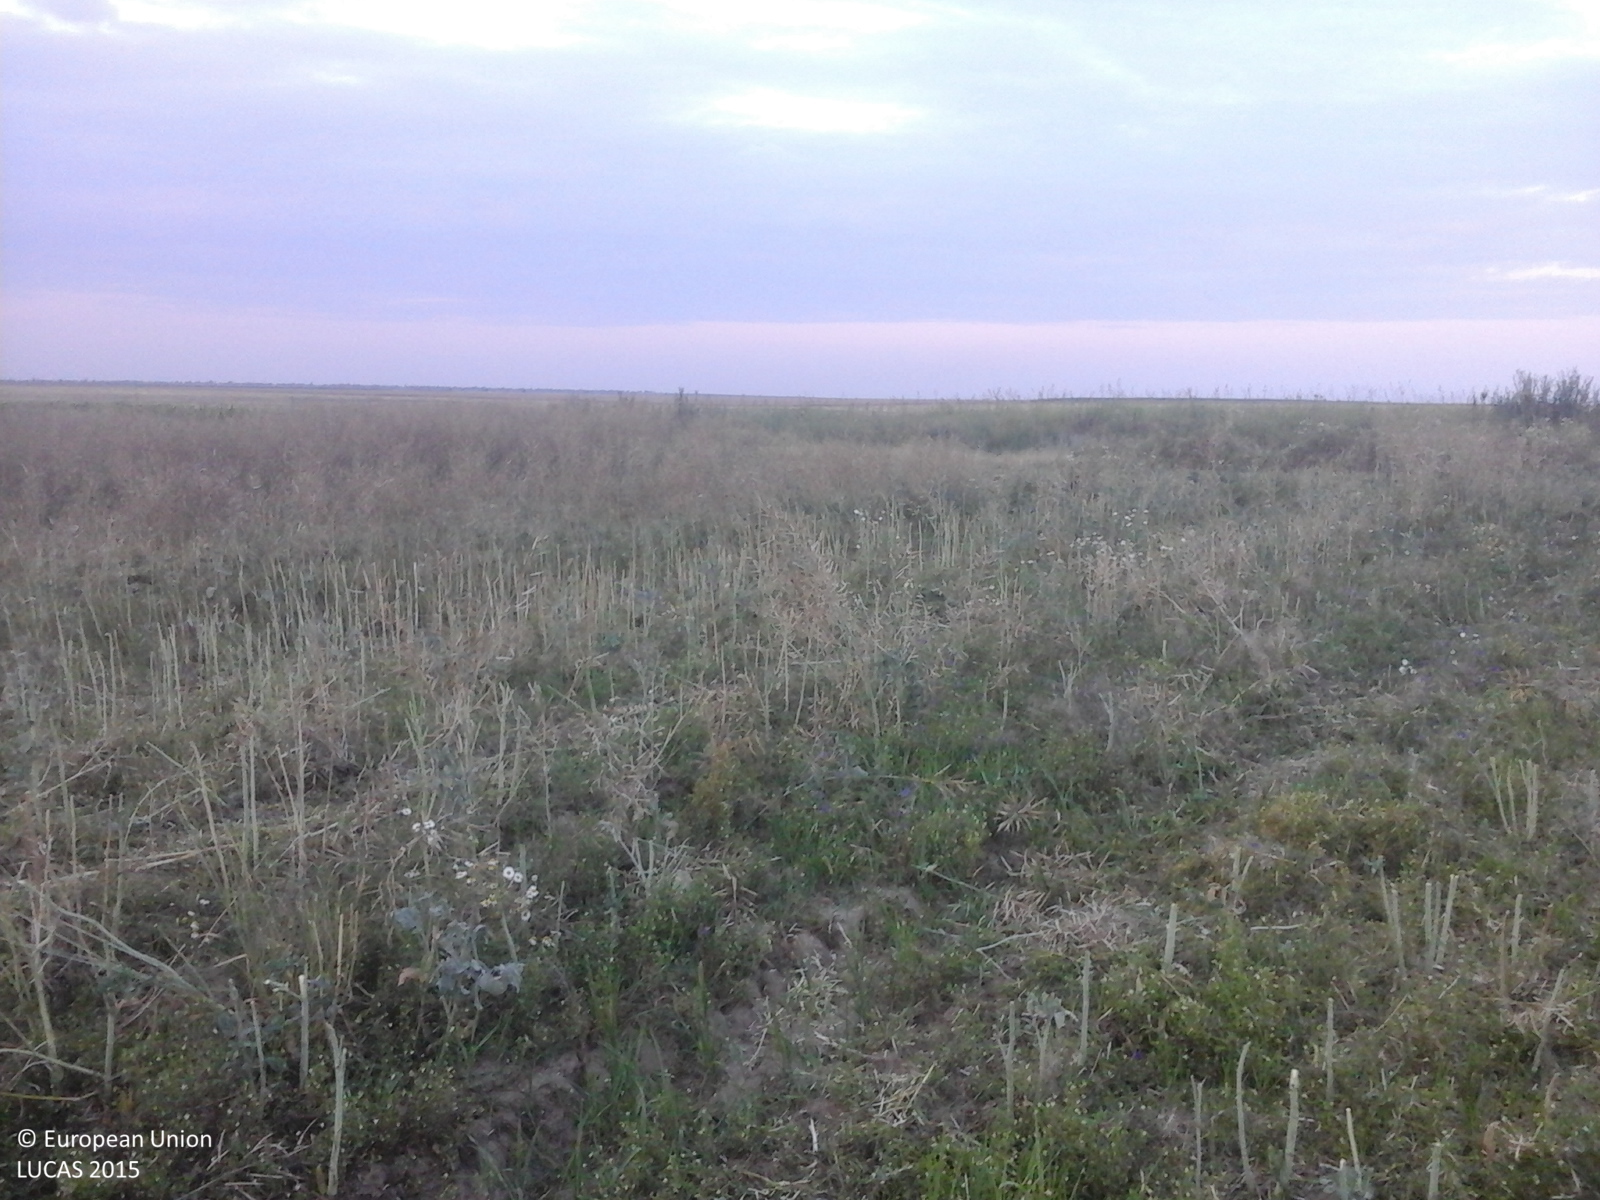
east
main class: Cropland
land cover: Rape and turnip rape
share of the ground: < 10 %
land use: Agriculture (excluding fallow land and kitchen gardens)
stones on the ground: < 10 %
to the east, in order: Rape and turnip rape; Tracks; Grassland without tree/shrub cover; Ditches and canals; Spontaneously vegetated surfaces; Common wheat
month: June
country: RO
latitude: 44.1653
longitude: 26.4559
